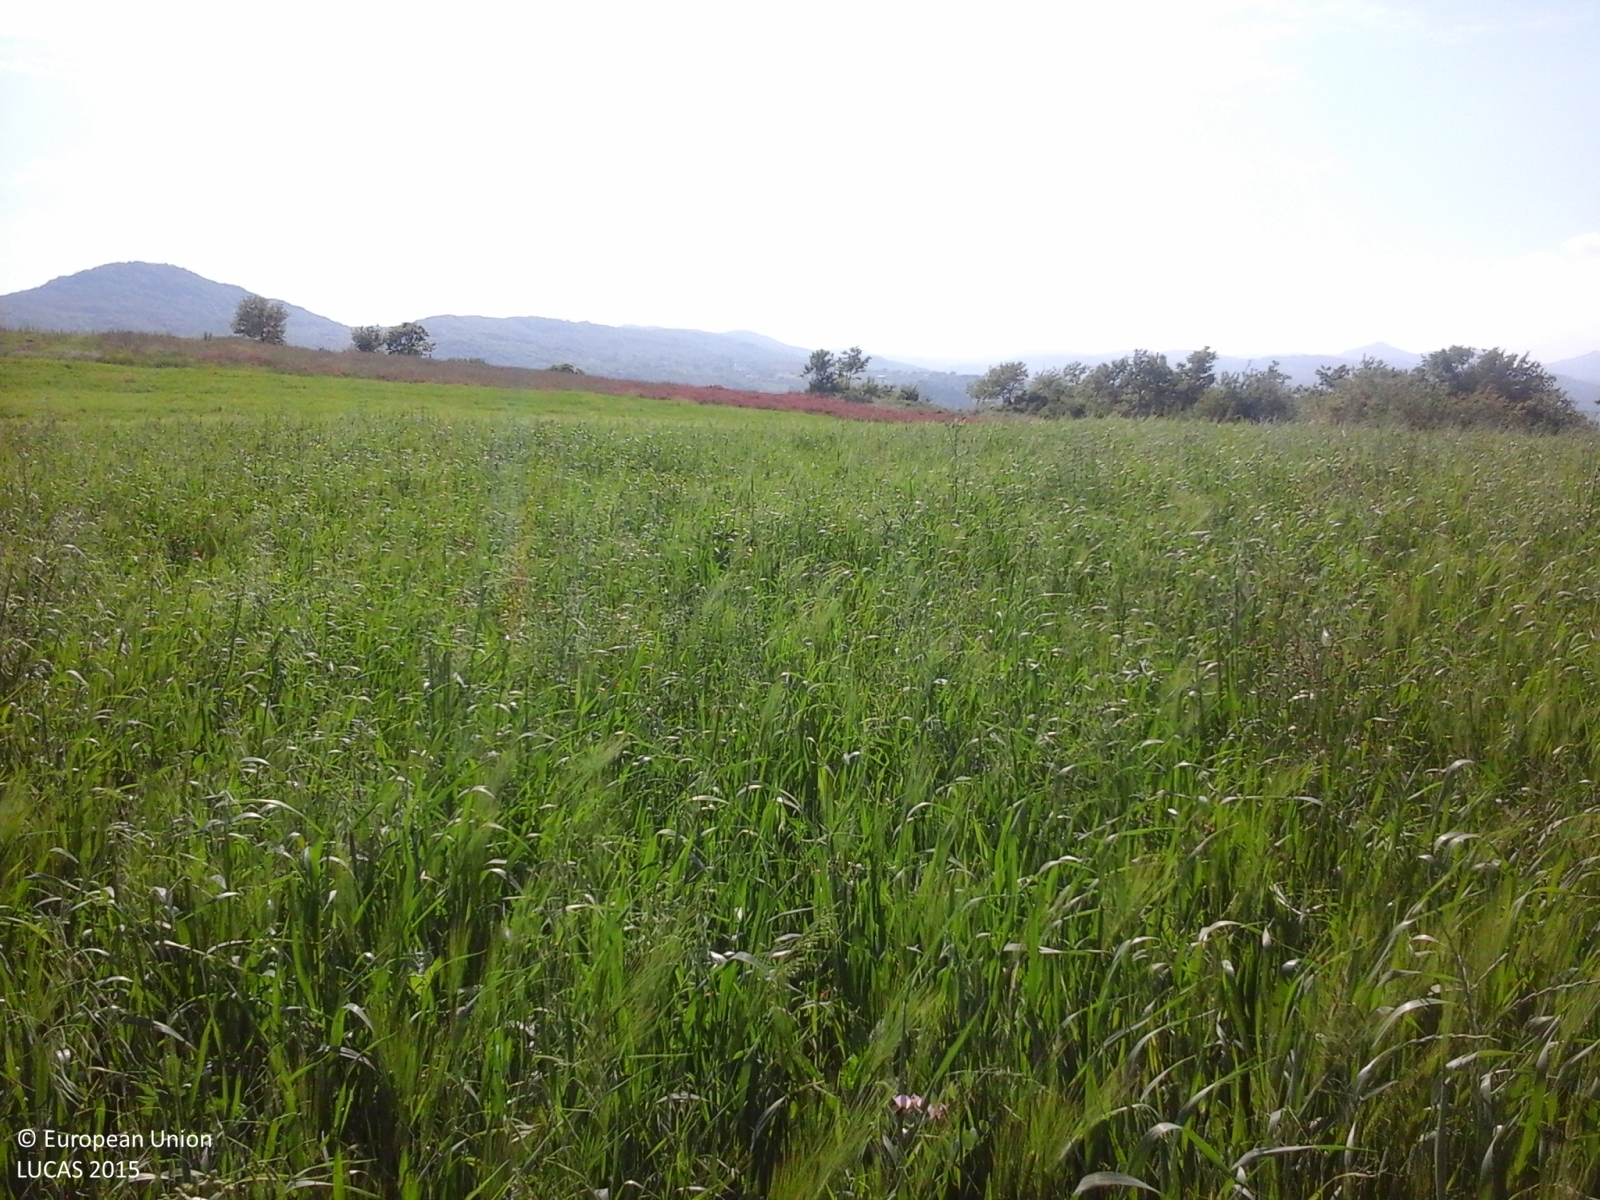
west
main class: Cropland
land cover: Barley
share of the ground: > 75 %
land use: Agriculture (excluding fallow land and kitchen gardens)
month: May
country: IT
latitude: 41.3323
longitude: 14.7026
